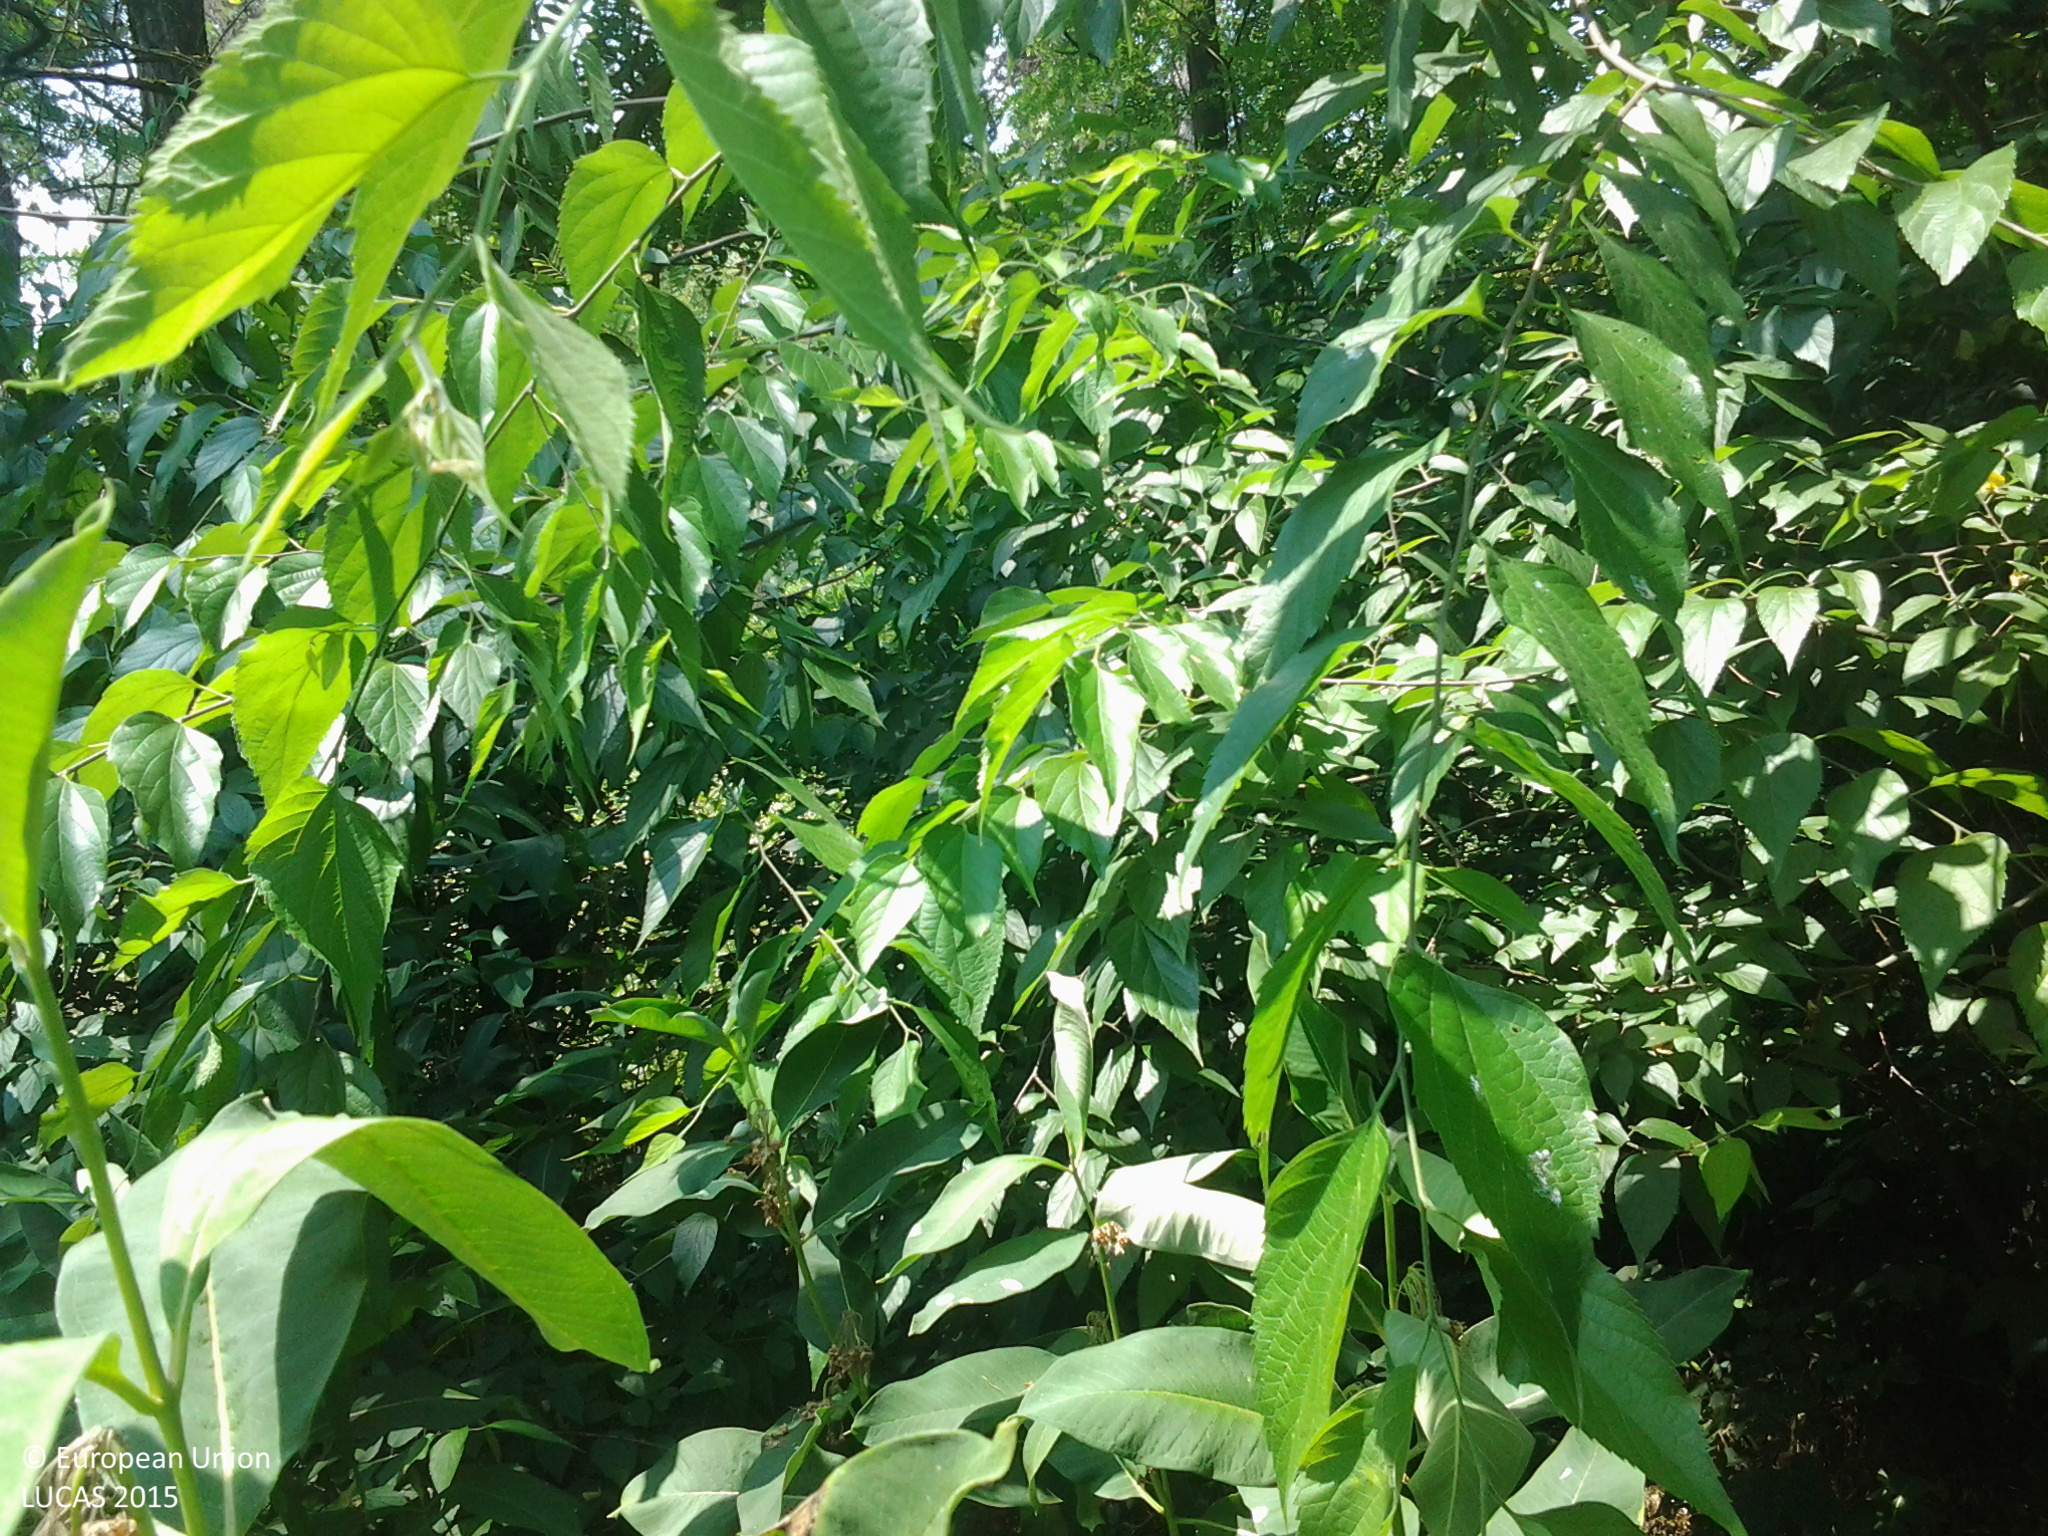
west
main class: Woodland
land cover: Pine dominated coniferous woodland
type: hemiboreal forest and nemoral coniferous forest and mixed broadleaved-coniferous forest
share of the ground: 50 - 75 %
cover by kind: coniferous forest trees 65 %, herbaceous plants 15 %, broadleaved forest trees 10 %, shrubs 10 %
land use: Forestry
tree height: > 5 m
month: July
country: HU
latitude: 46.6550
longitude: 19.6763
